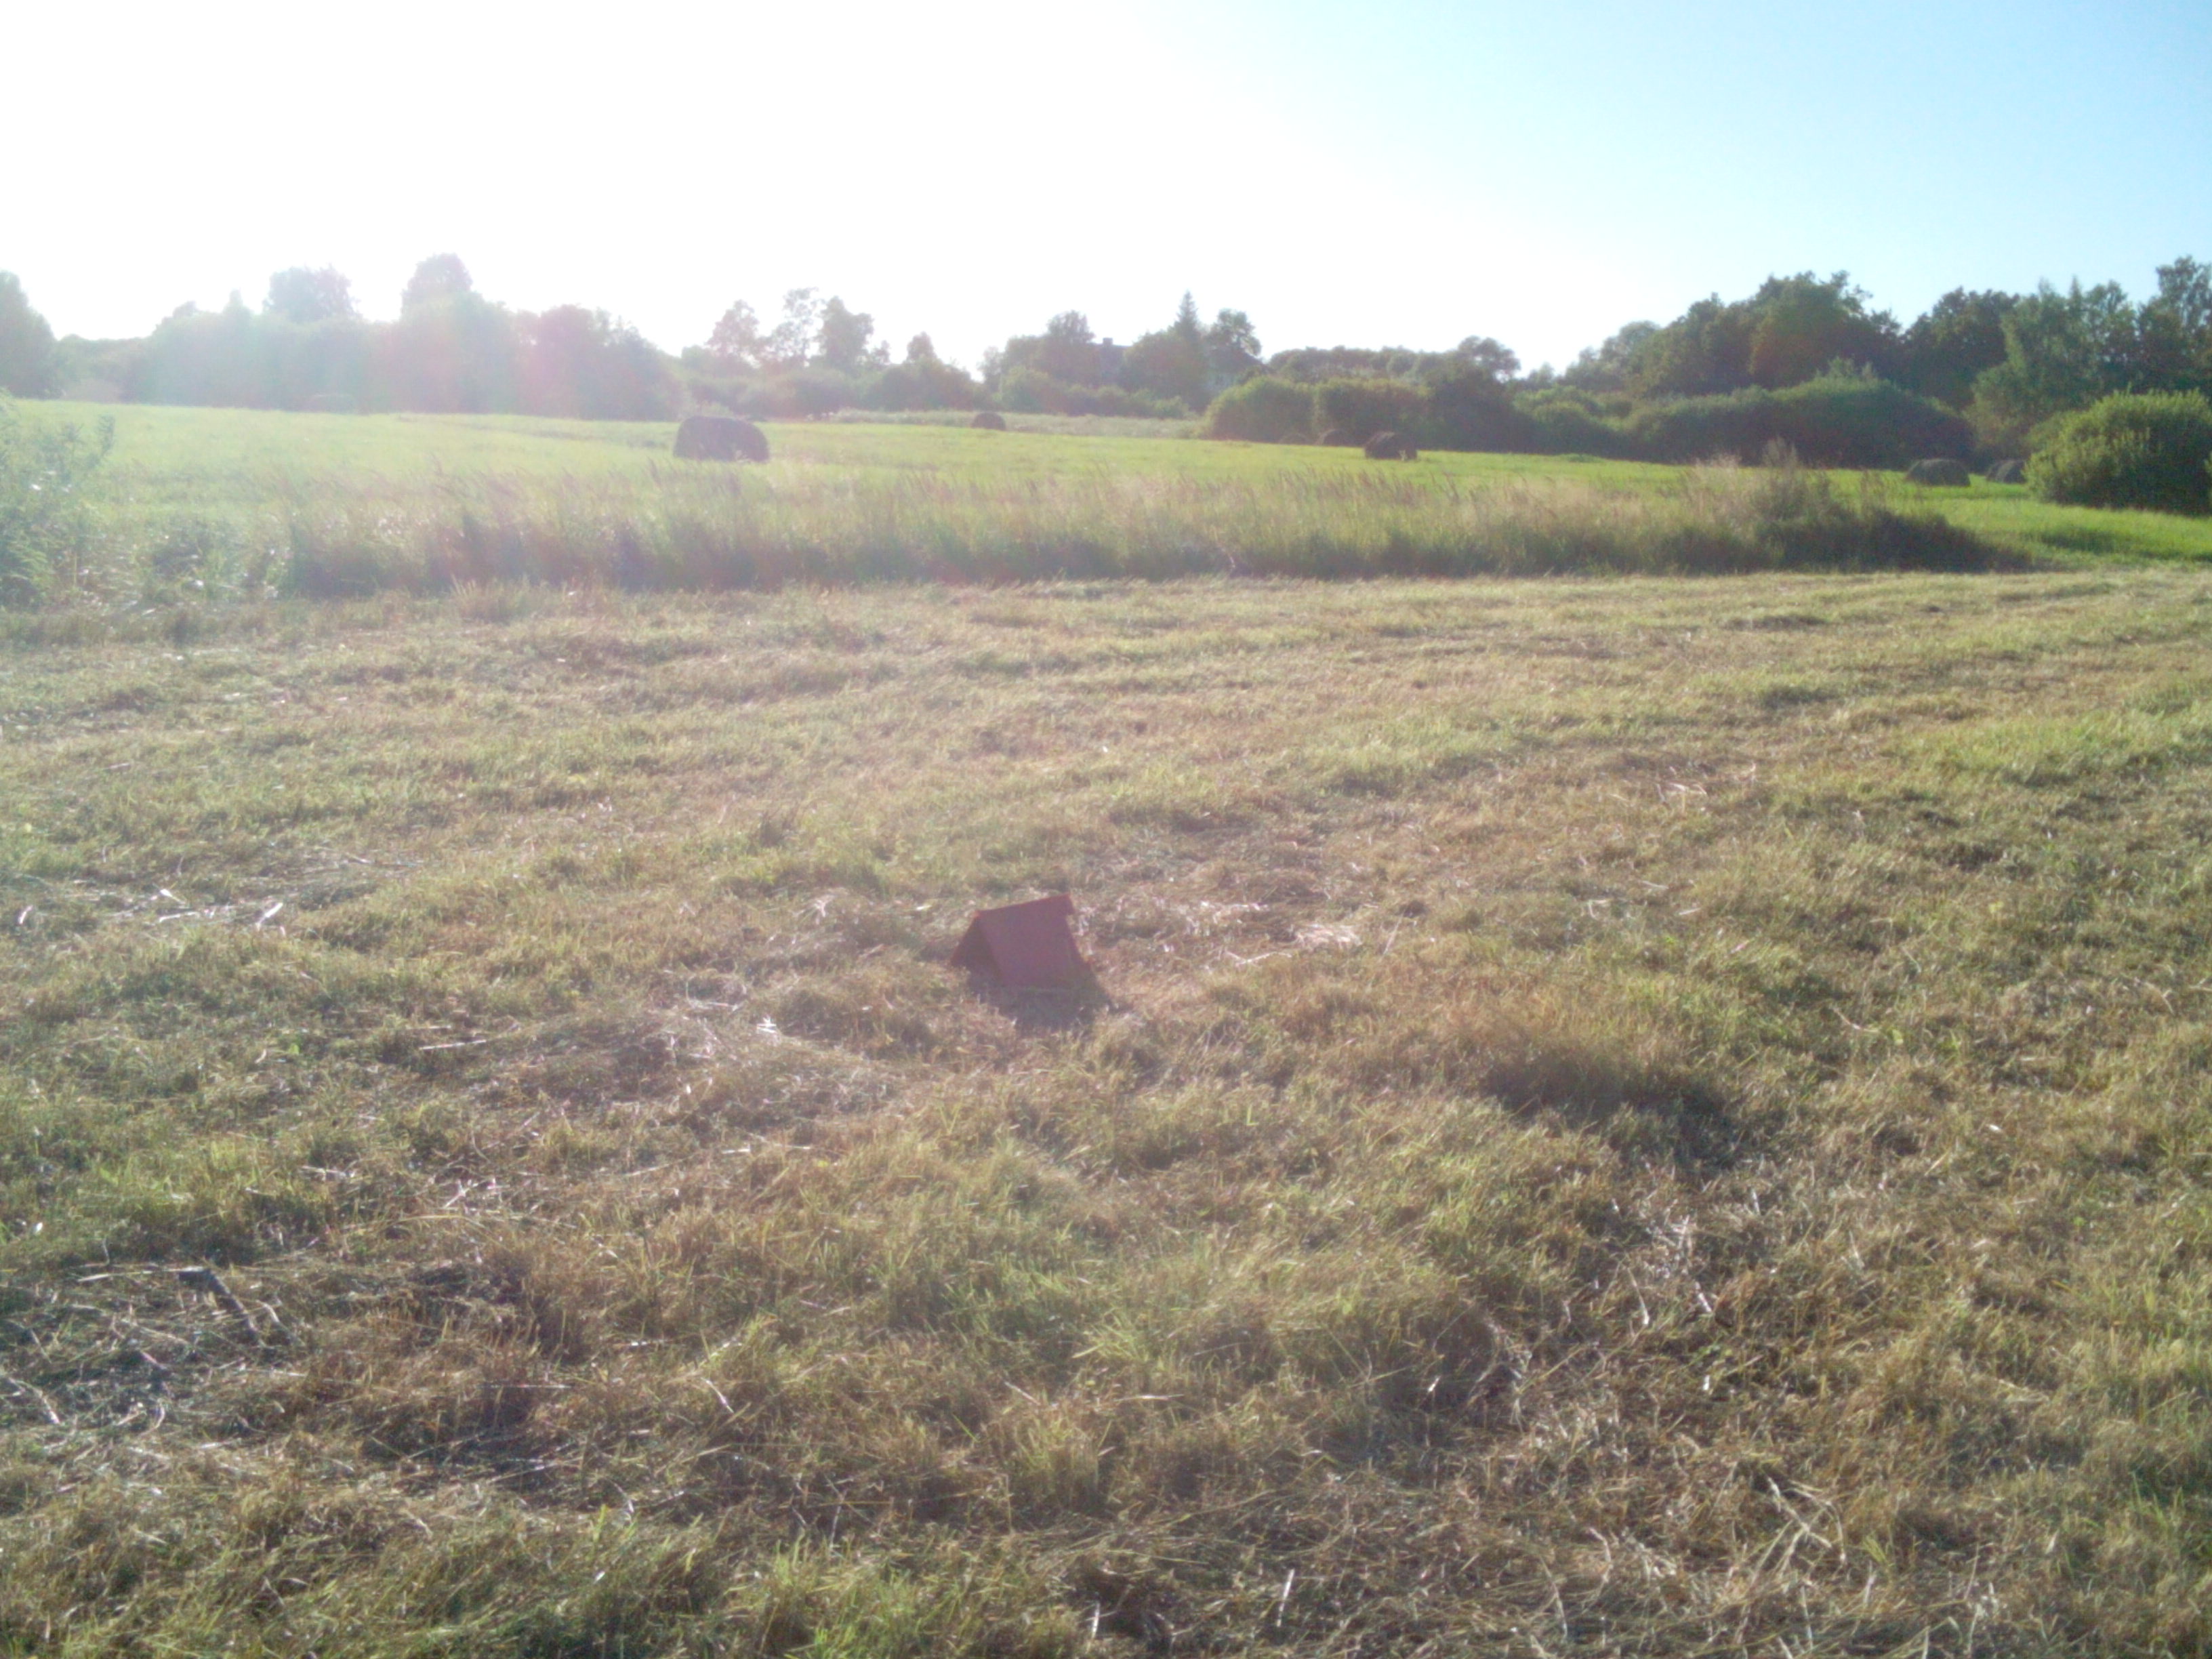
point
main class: Grassland
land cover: Grassland without tree/shrub cover
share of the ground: > 75 %
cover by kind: herbaceous plants 100 %
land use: Agriculture (excluding fallow land and kitchen gardens)
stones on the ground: < 10 %
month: August
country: LV
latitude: 56.5523
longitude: 21.3790
